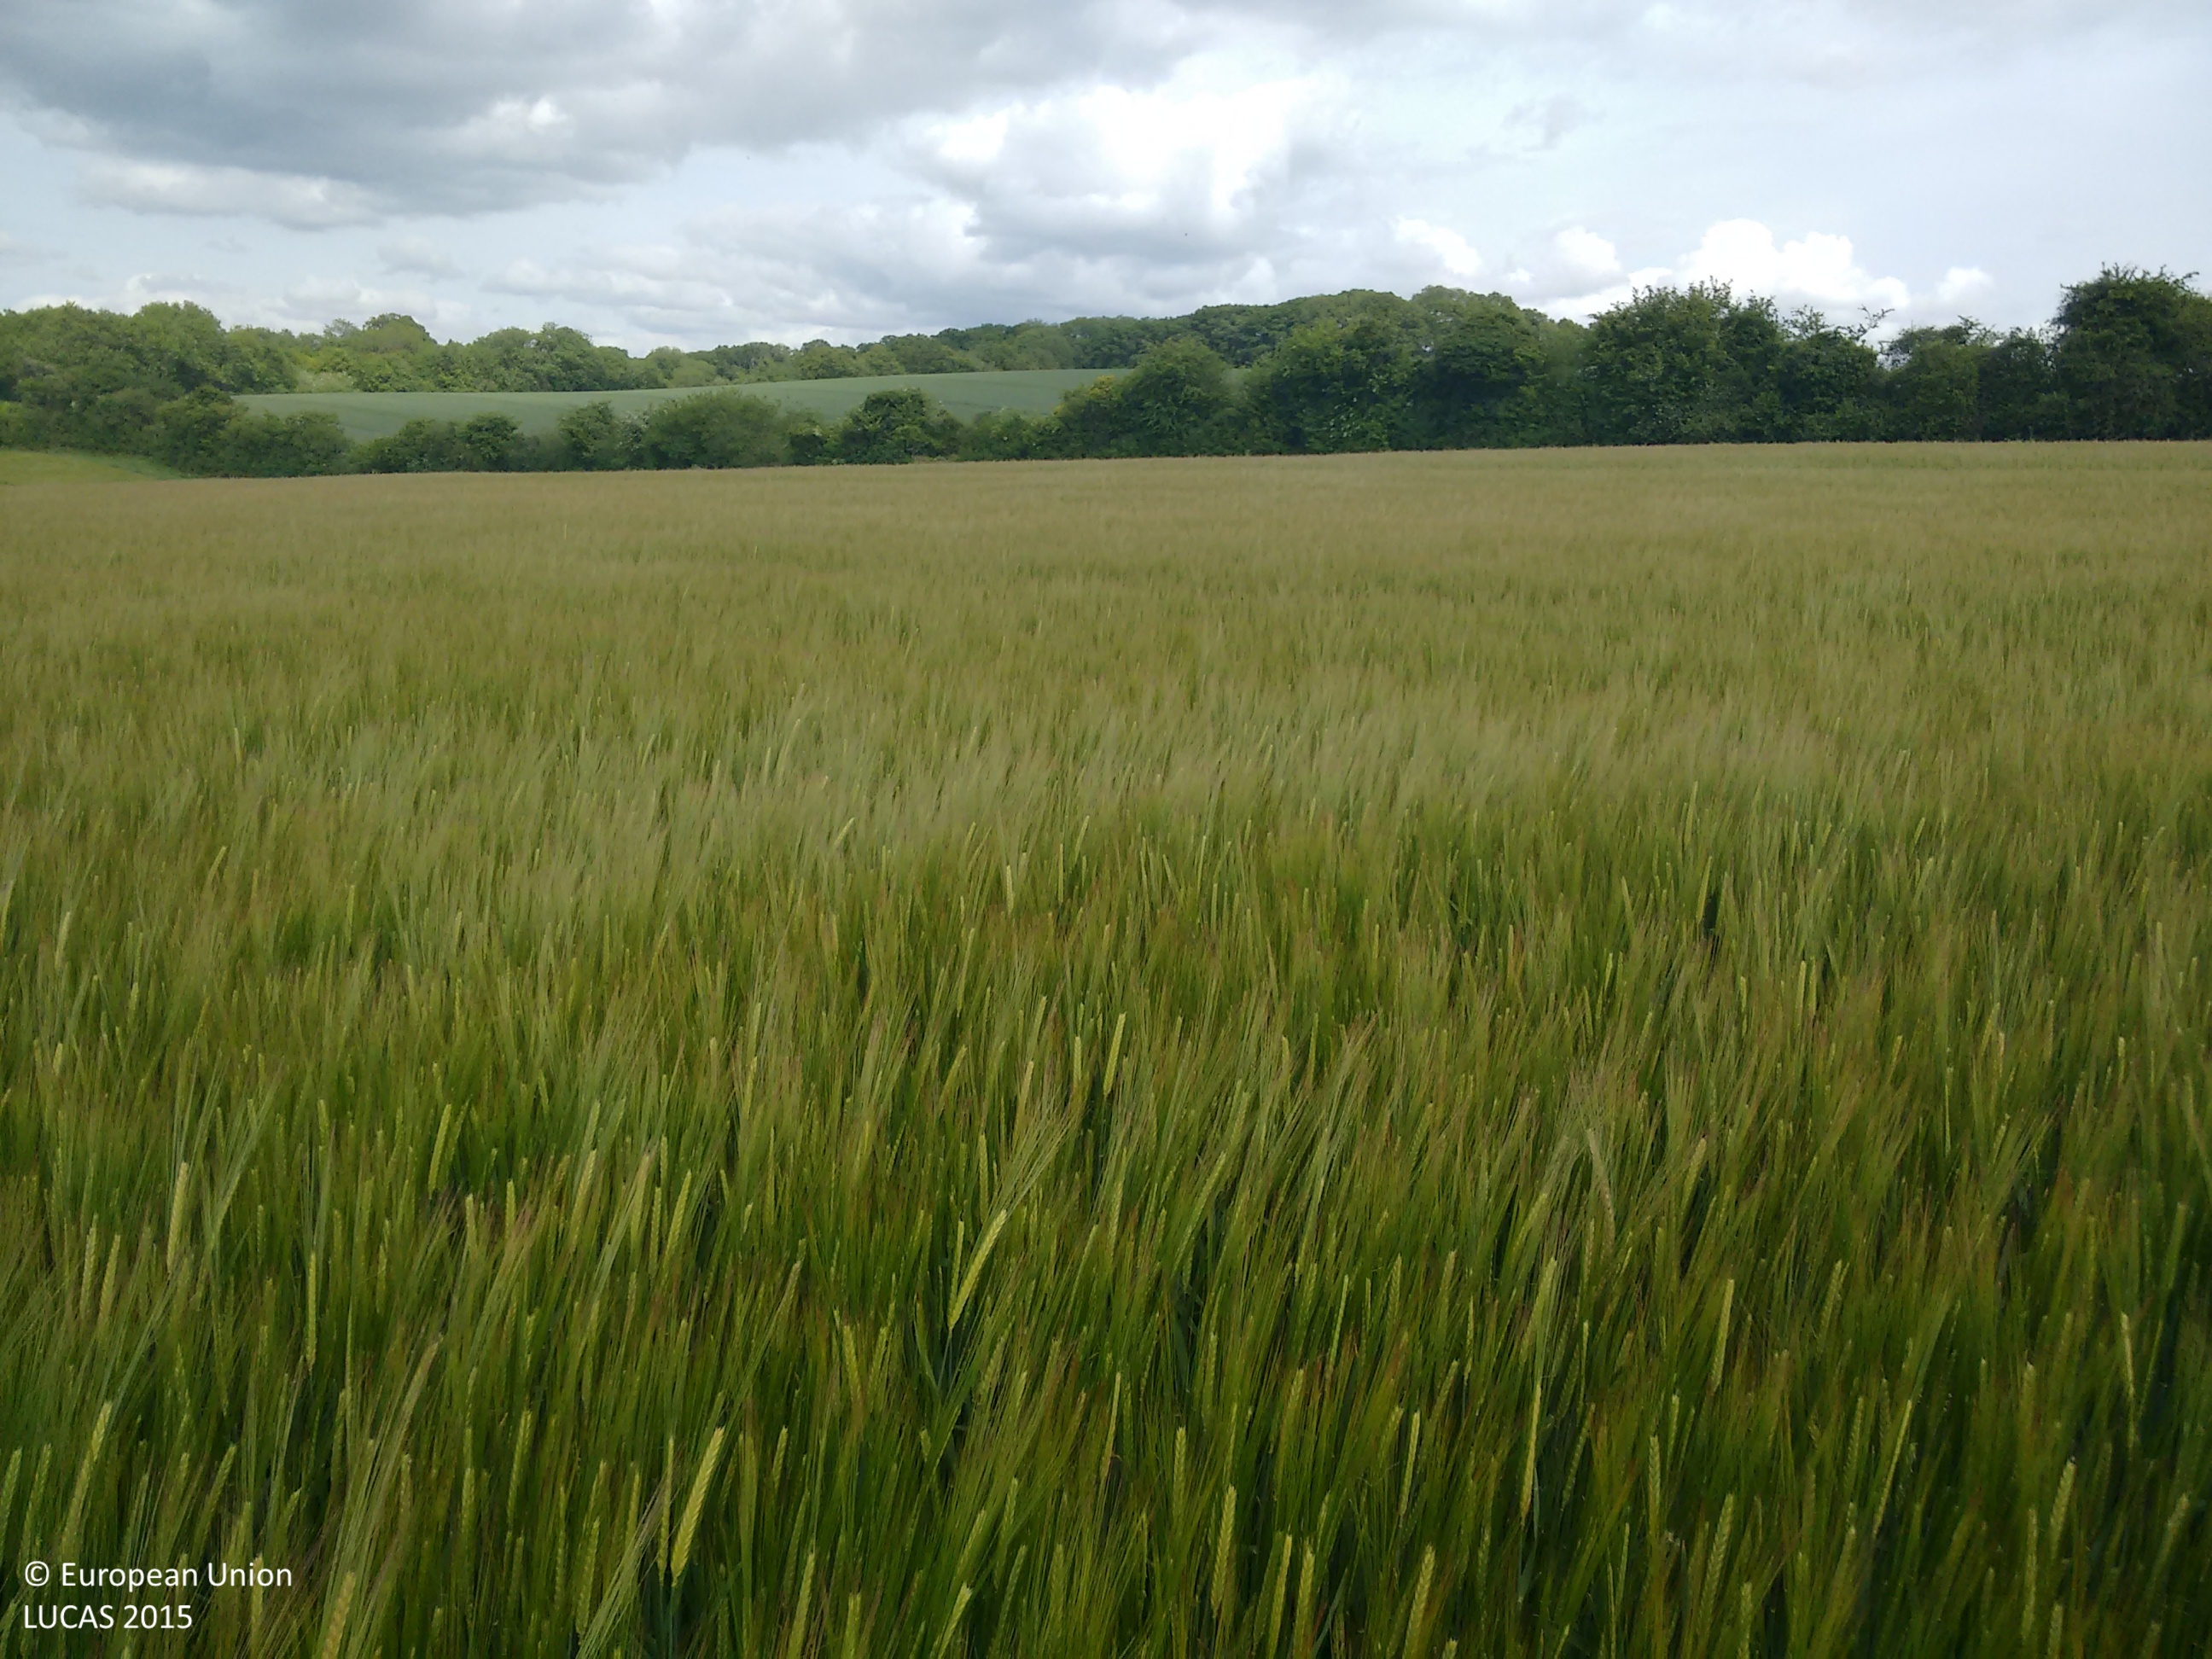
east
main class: Cropland
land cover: Barley
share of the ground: > 75 %
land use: Agriculture (excluding fallow land and kitchen gardens)
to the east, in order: Barley; Spontaneously vegetated surfaces; Managed hedges; Fences; Grass margins; Common wheat
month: May
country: GB
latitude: 50.8328
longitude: -2.0569
